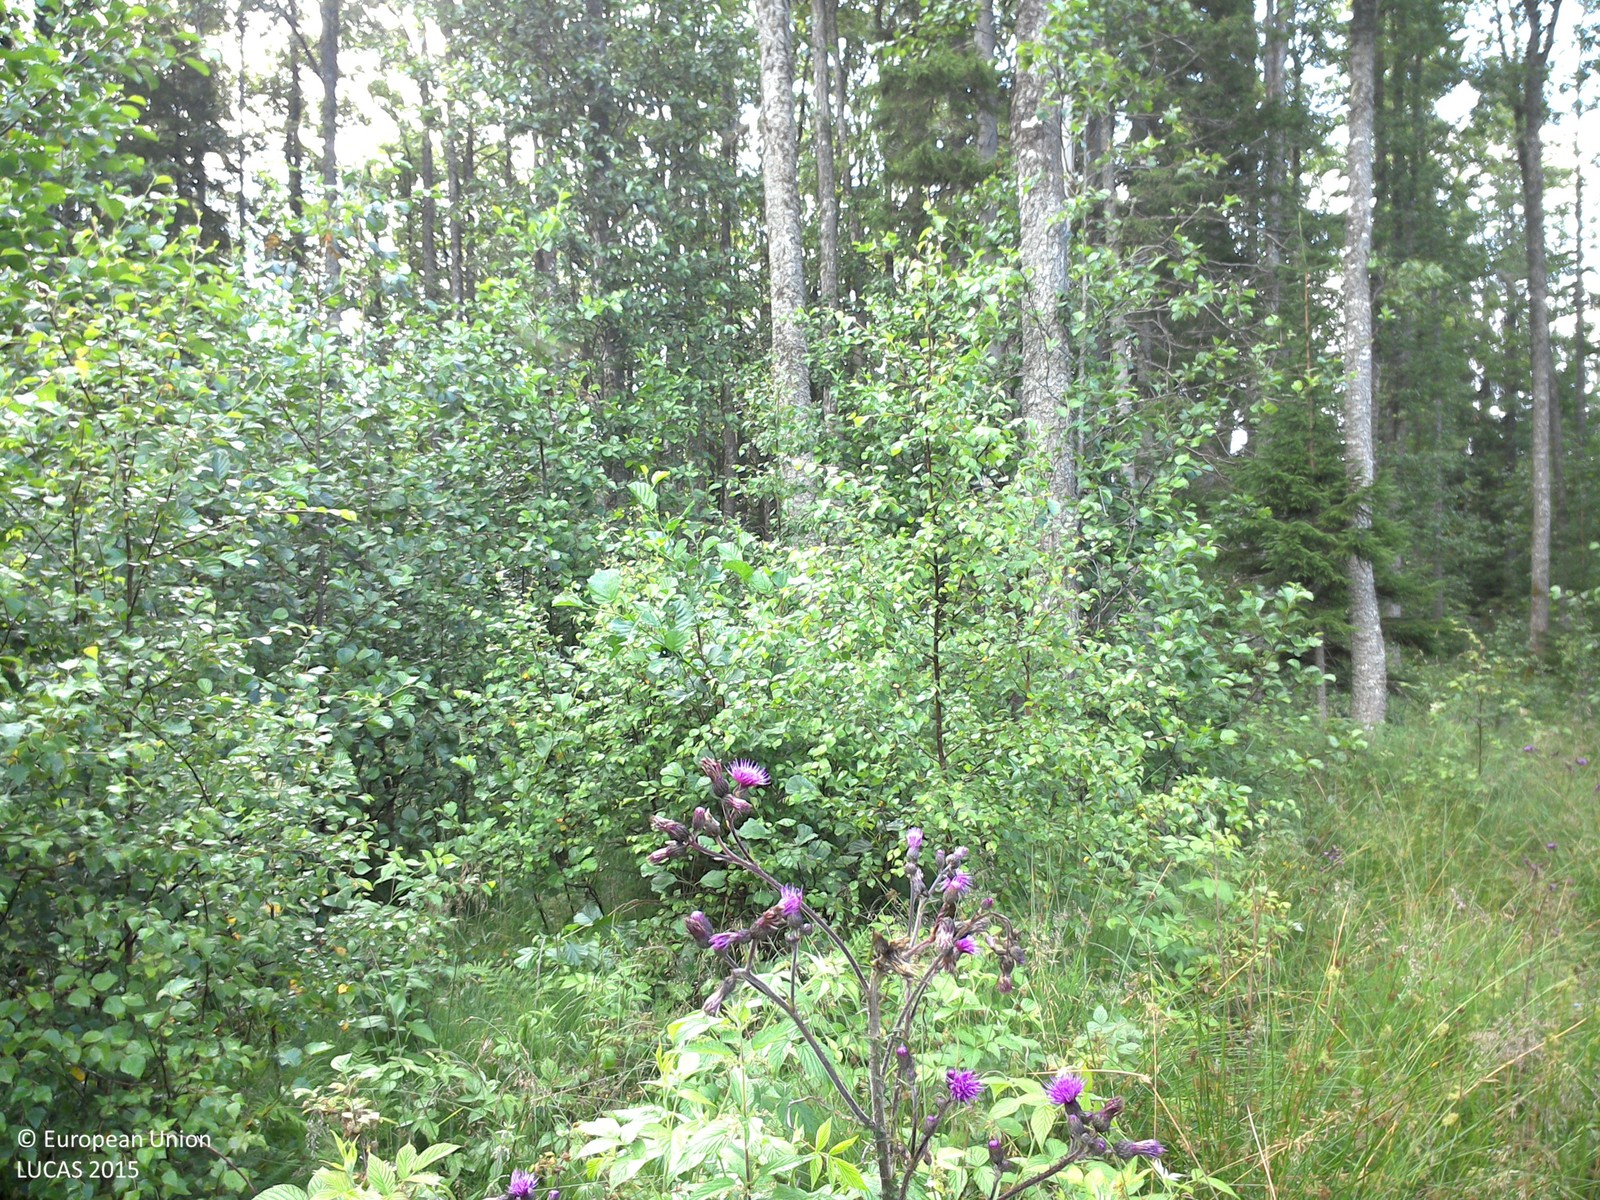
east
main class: Woodland
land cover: Broadleaved woodland
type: boreal forest
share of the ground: > 75 %
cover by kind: broadleaved forest trees 80 %, shrubs 10 %, herbaceous plants 10 %
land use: Forestry
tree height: < 5 m
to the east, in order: Broadleaved woodland; Spruce dominated mixed woodland; Spruce dominated coniferous woodland; Spruce dominated mixed woodland; Grassland with sparse tree/shrub cover
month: July
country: SE
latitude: 57.9508
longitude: 14.8779
